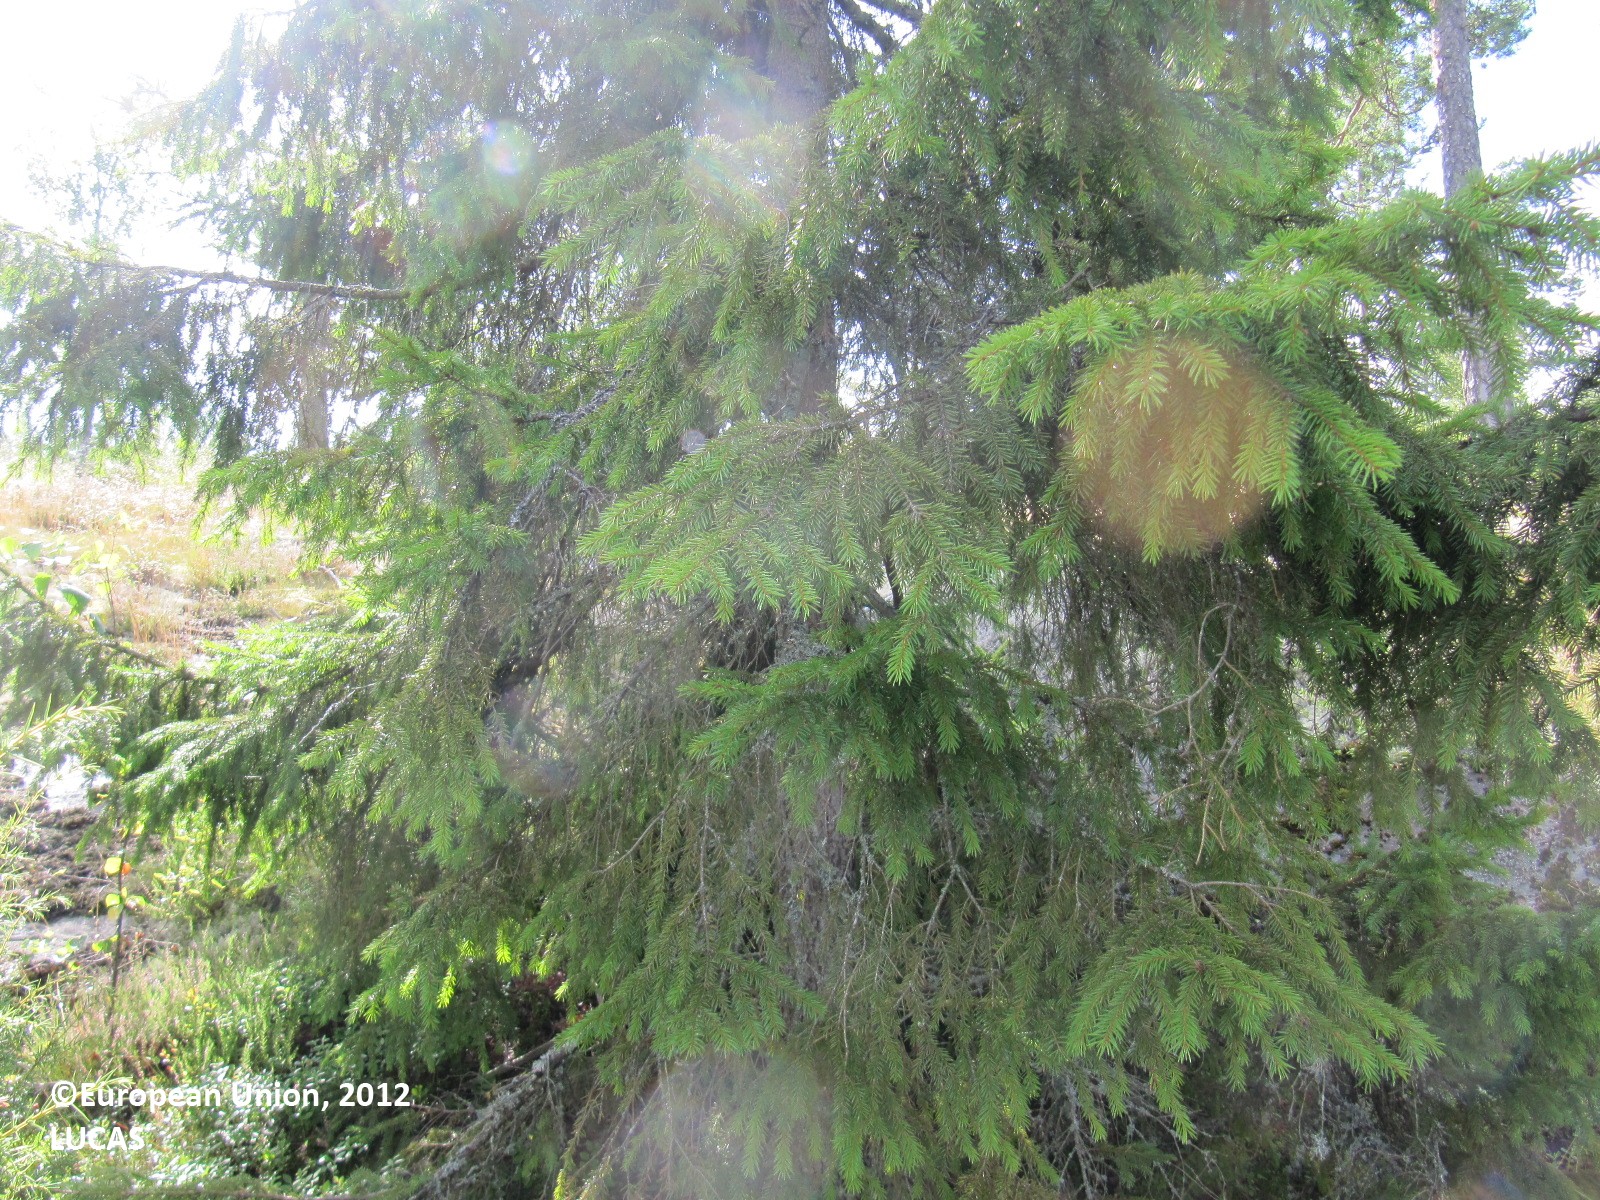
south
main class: Woodland
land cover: Pine dominated mixed woodland
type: boreal forest
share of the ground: 25 - 50 %
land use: Forestry
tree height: > 5 m
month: August
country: FI
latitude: 61.0120
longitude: 22.8918
